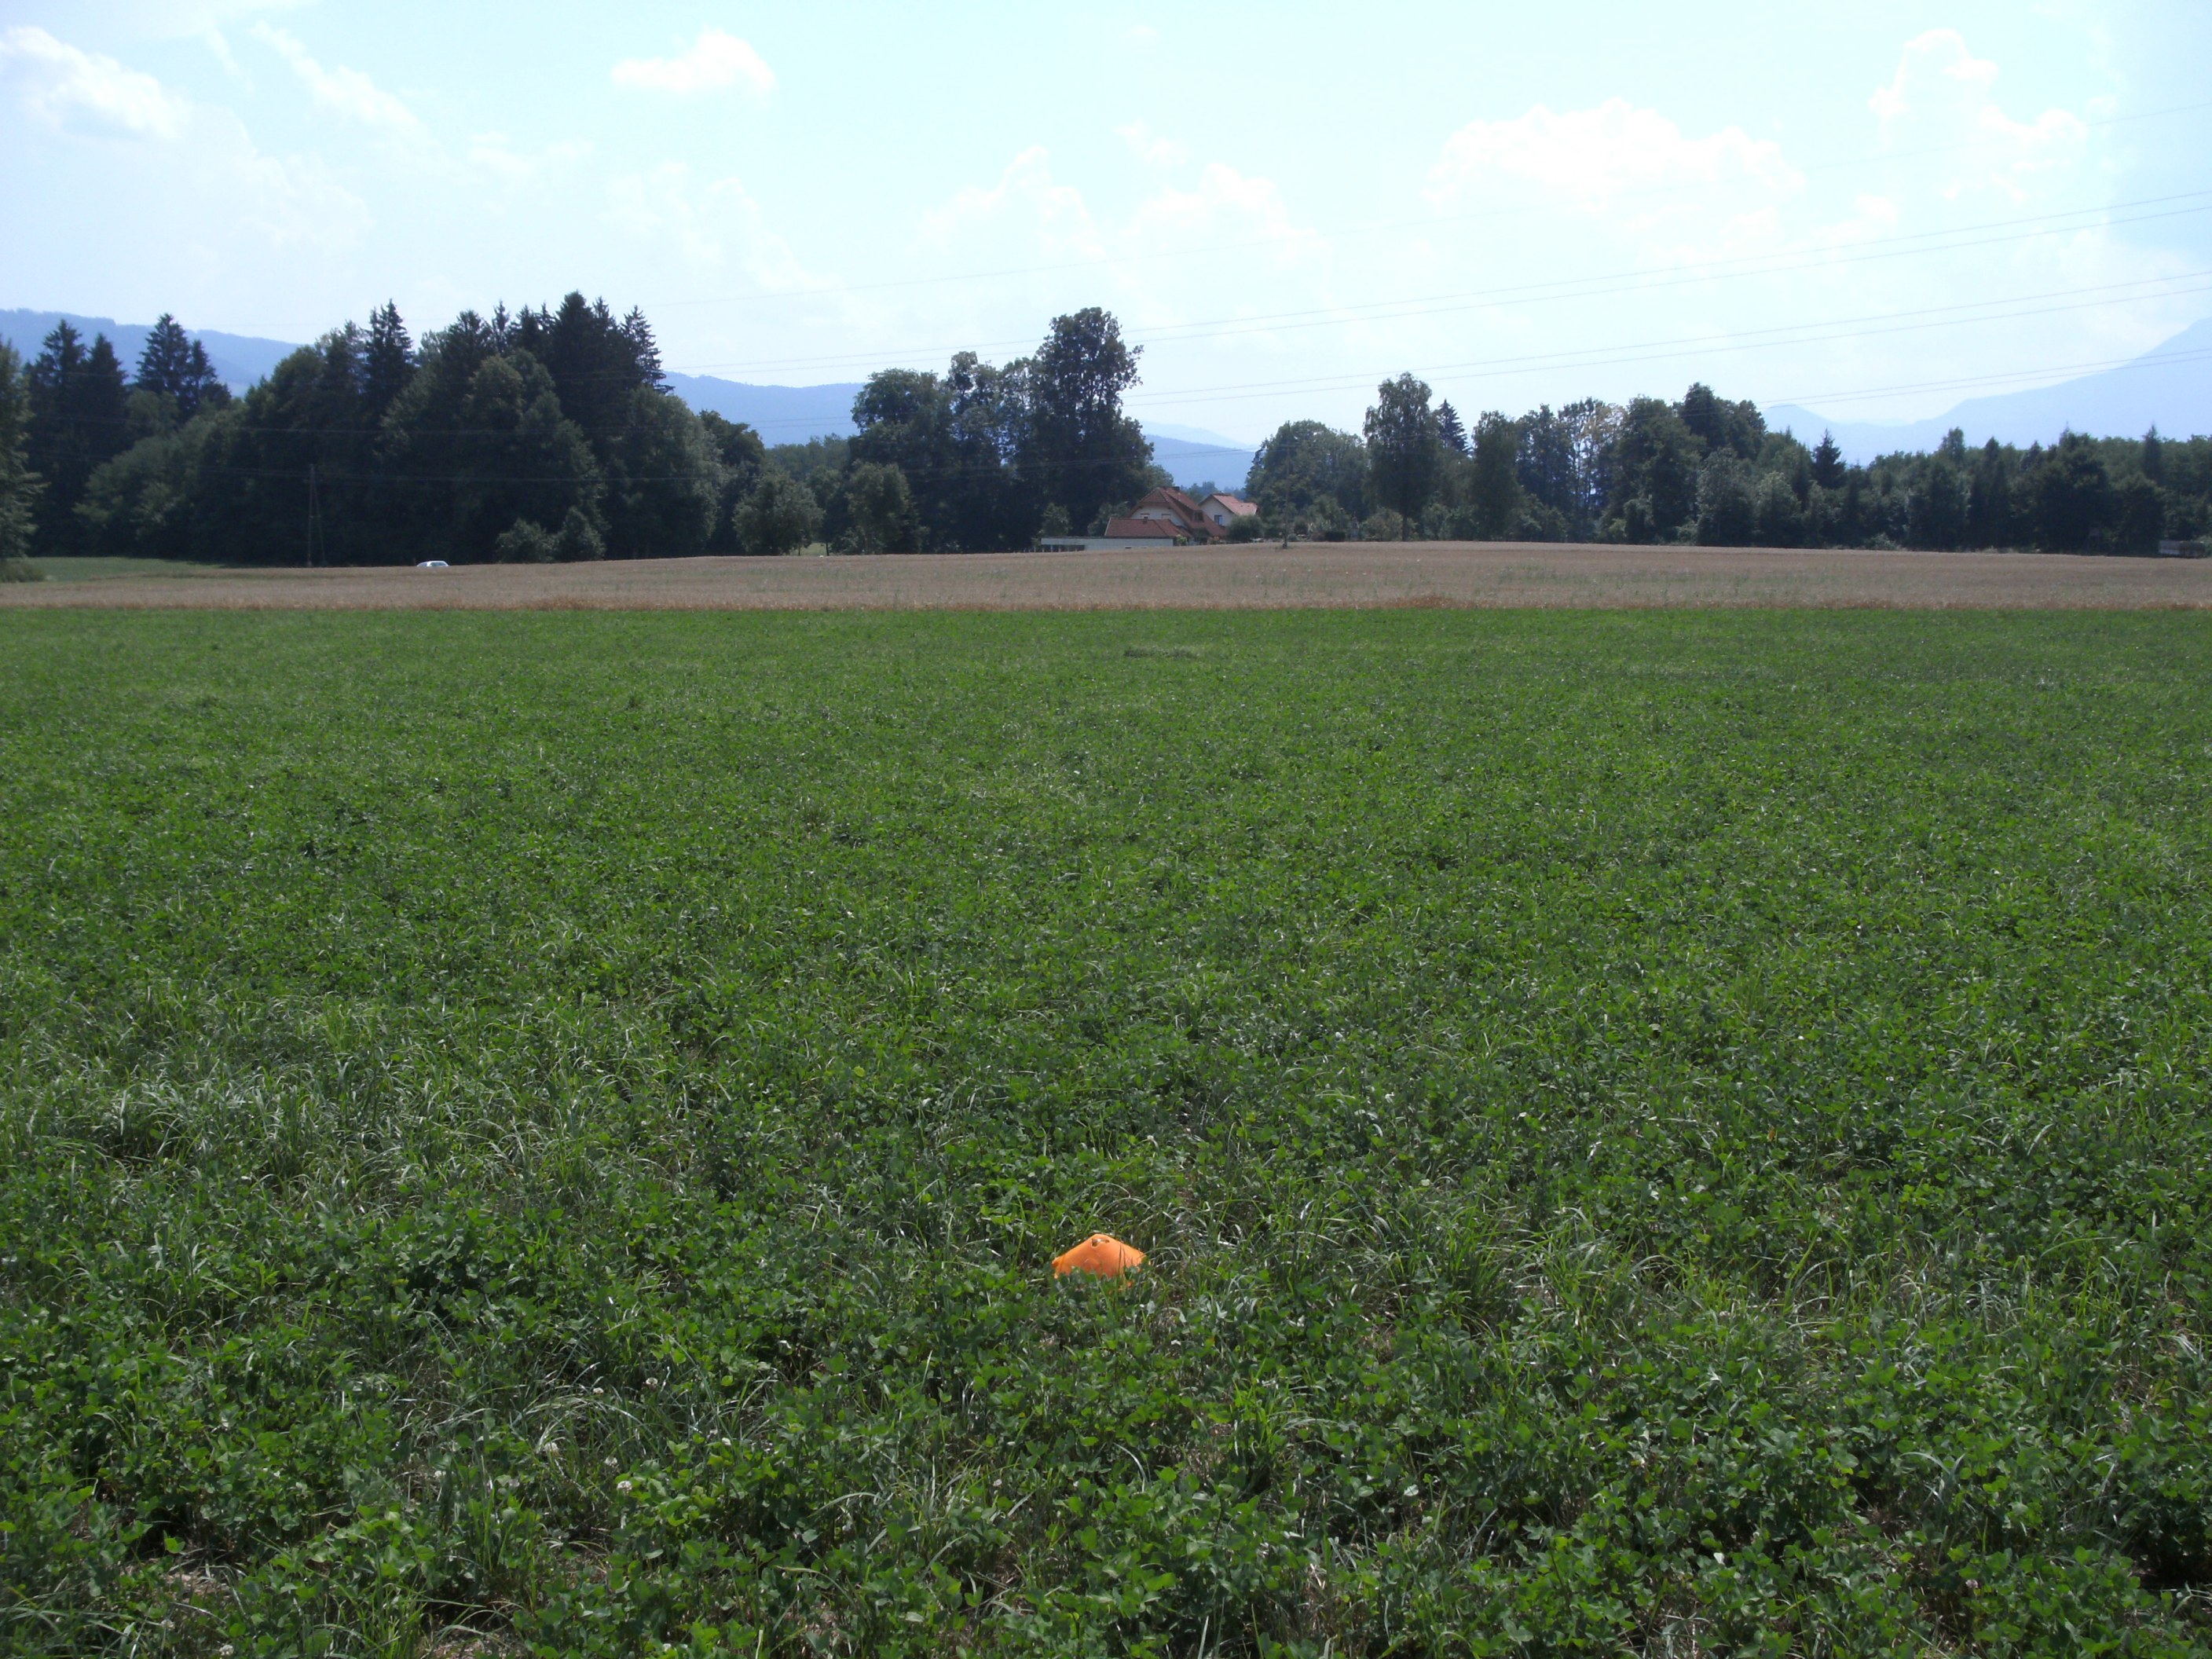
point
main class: Cropland
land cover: Temporary grasslands
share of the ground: > 75 %
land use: Agriculture (excluding fallow land and kitchen gardens)
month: July
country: AT
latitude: 46.6419
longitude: 14.7663
